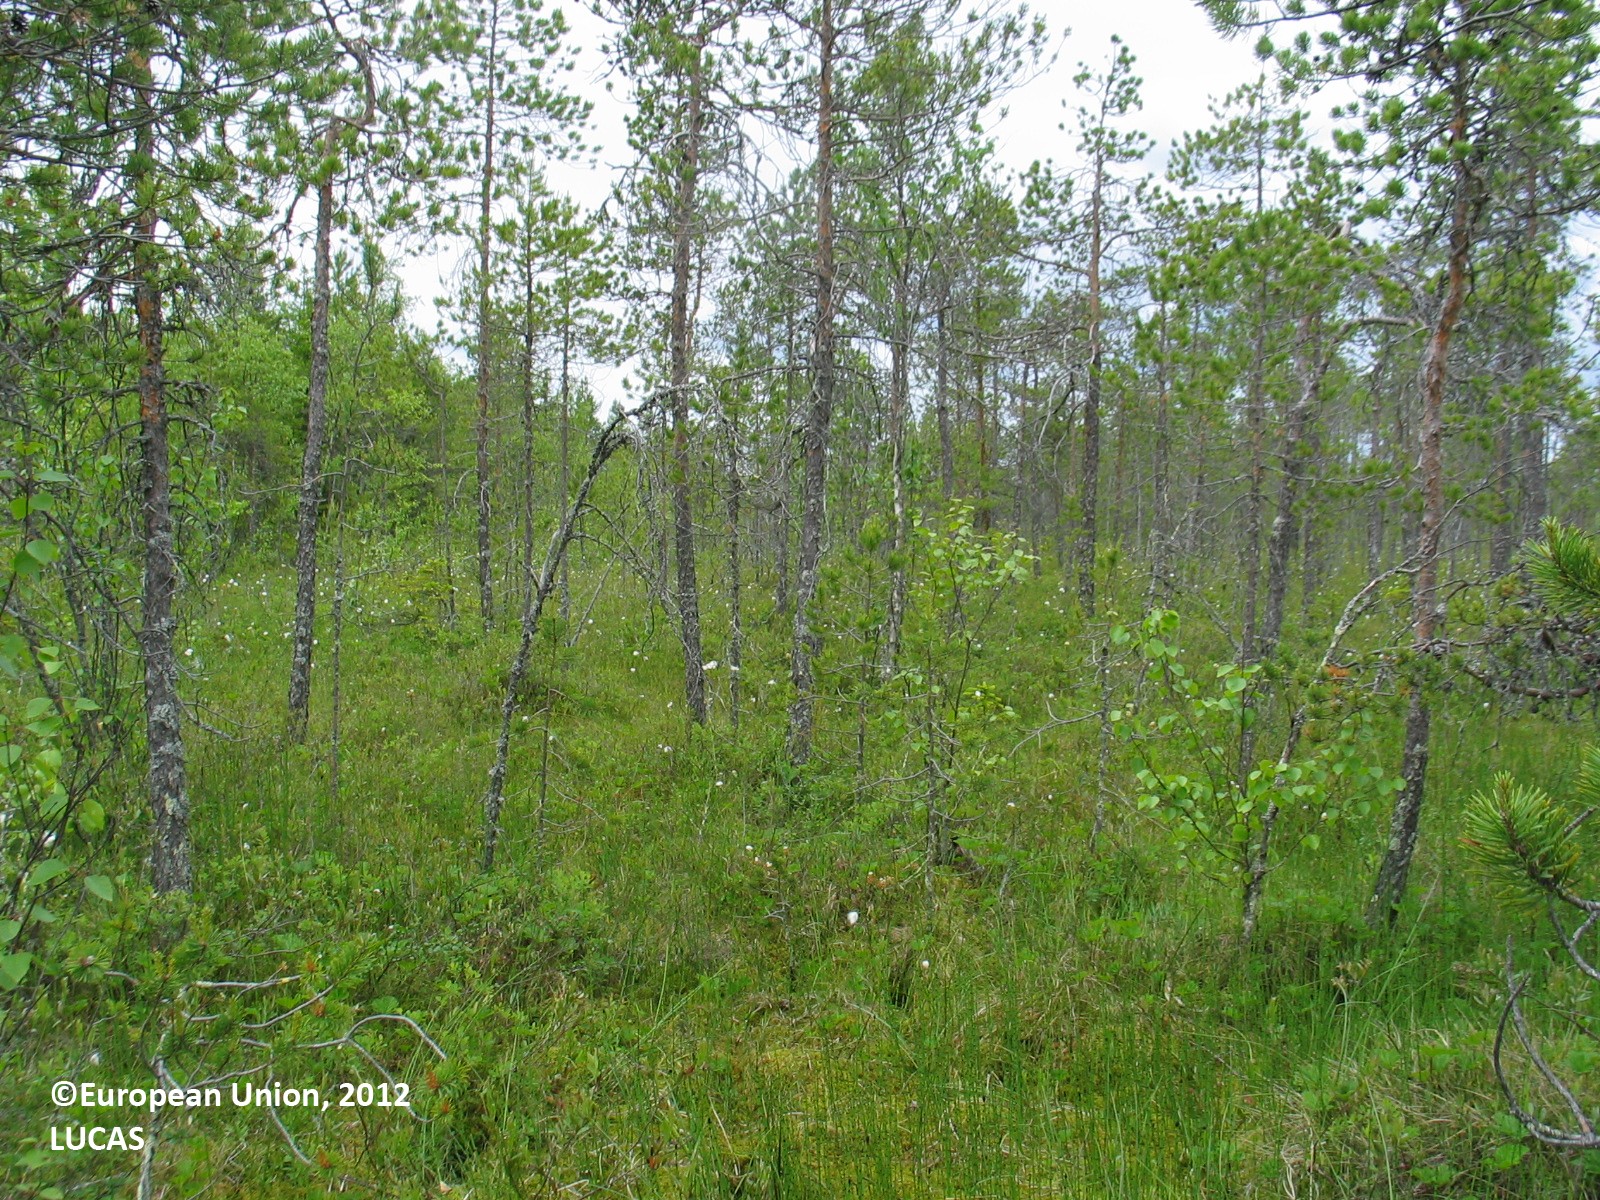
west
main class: Woodland
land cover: Pine dominated coniferous woodland
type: mire and swamp forests
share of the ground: 10 - 25 %
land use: Semi-natural and natural areas not in use
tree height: > 5 m
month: June
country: FI
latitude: 64.8653
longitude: 26.6351
